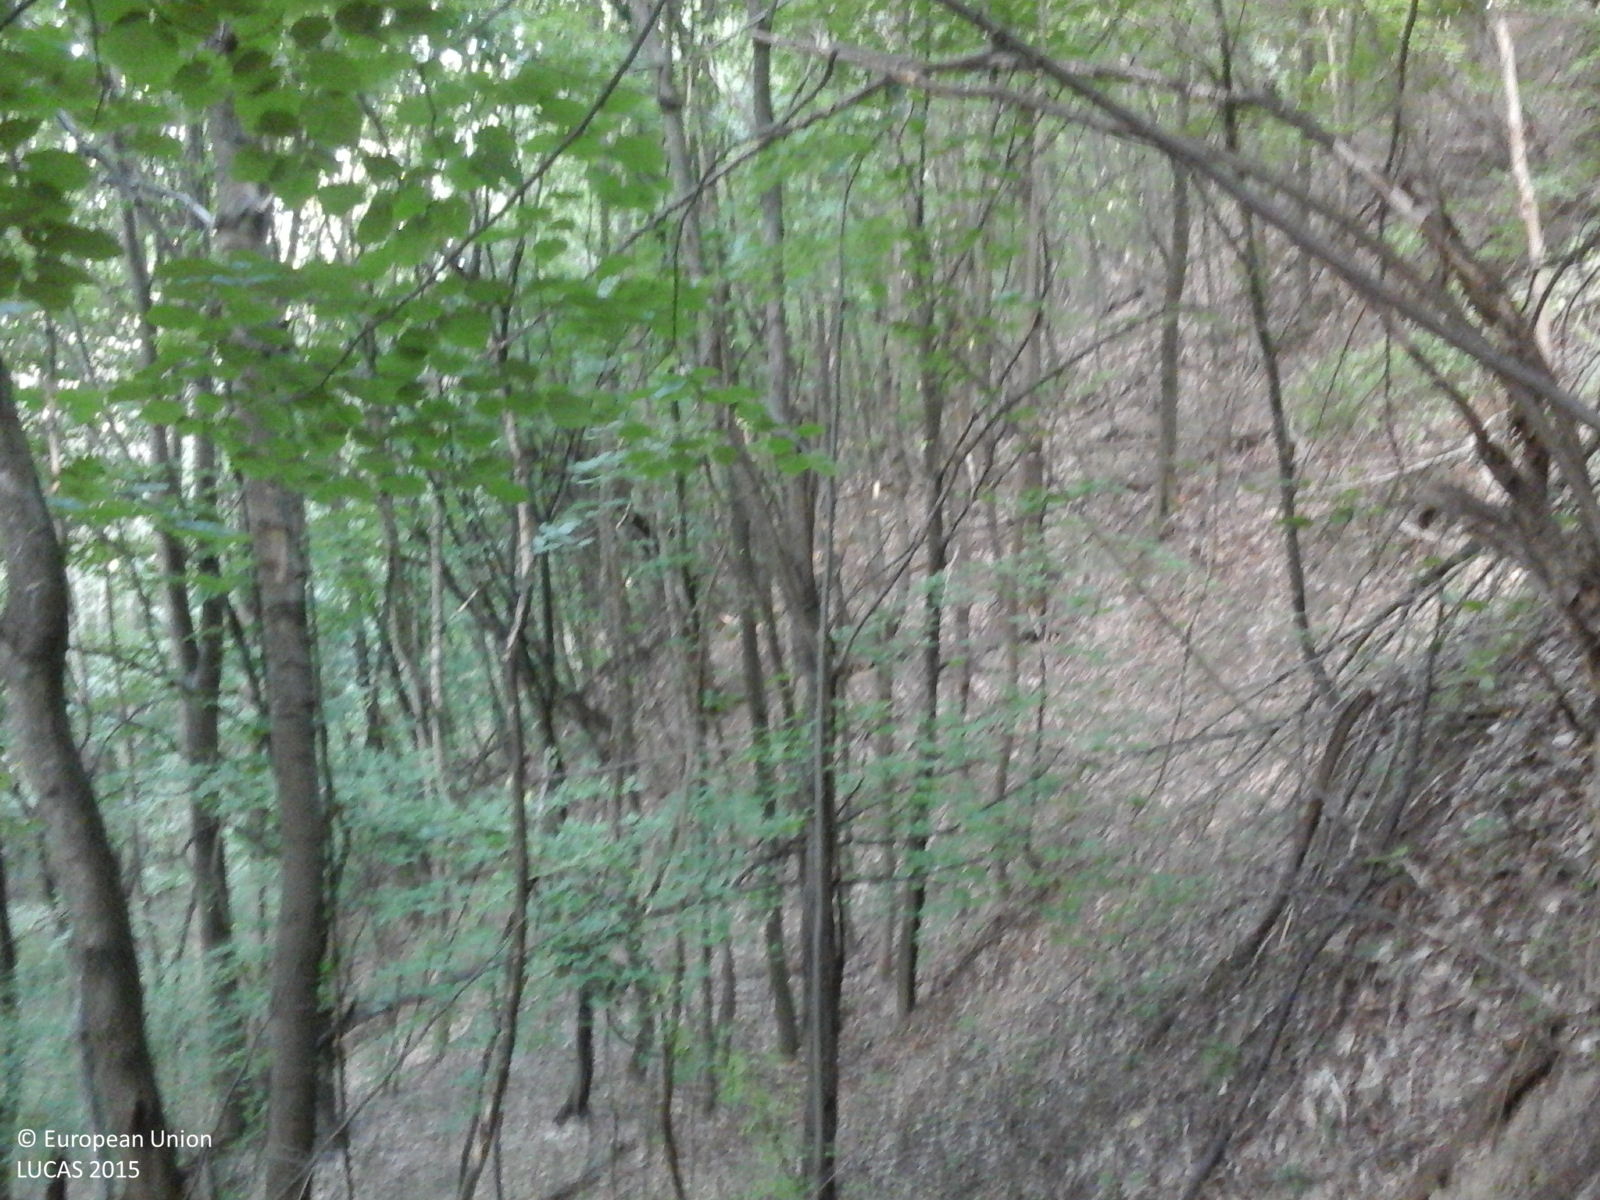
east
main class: Woodland
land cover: Broadleaved woodland
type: beech forest
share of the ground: > 75 %
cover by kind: broadleaved forest trees 100 %
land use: Forestry
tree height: > 5 m
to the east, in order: Broadleaved woodland
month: June
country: RO
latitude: 46.7722
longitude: 27.2745
